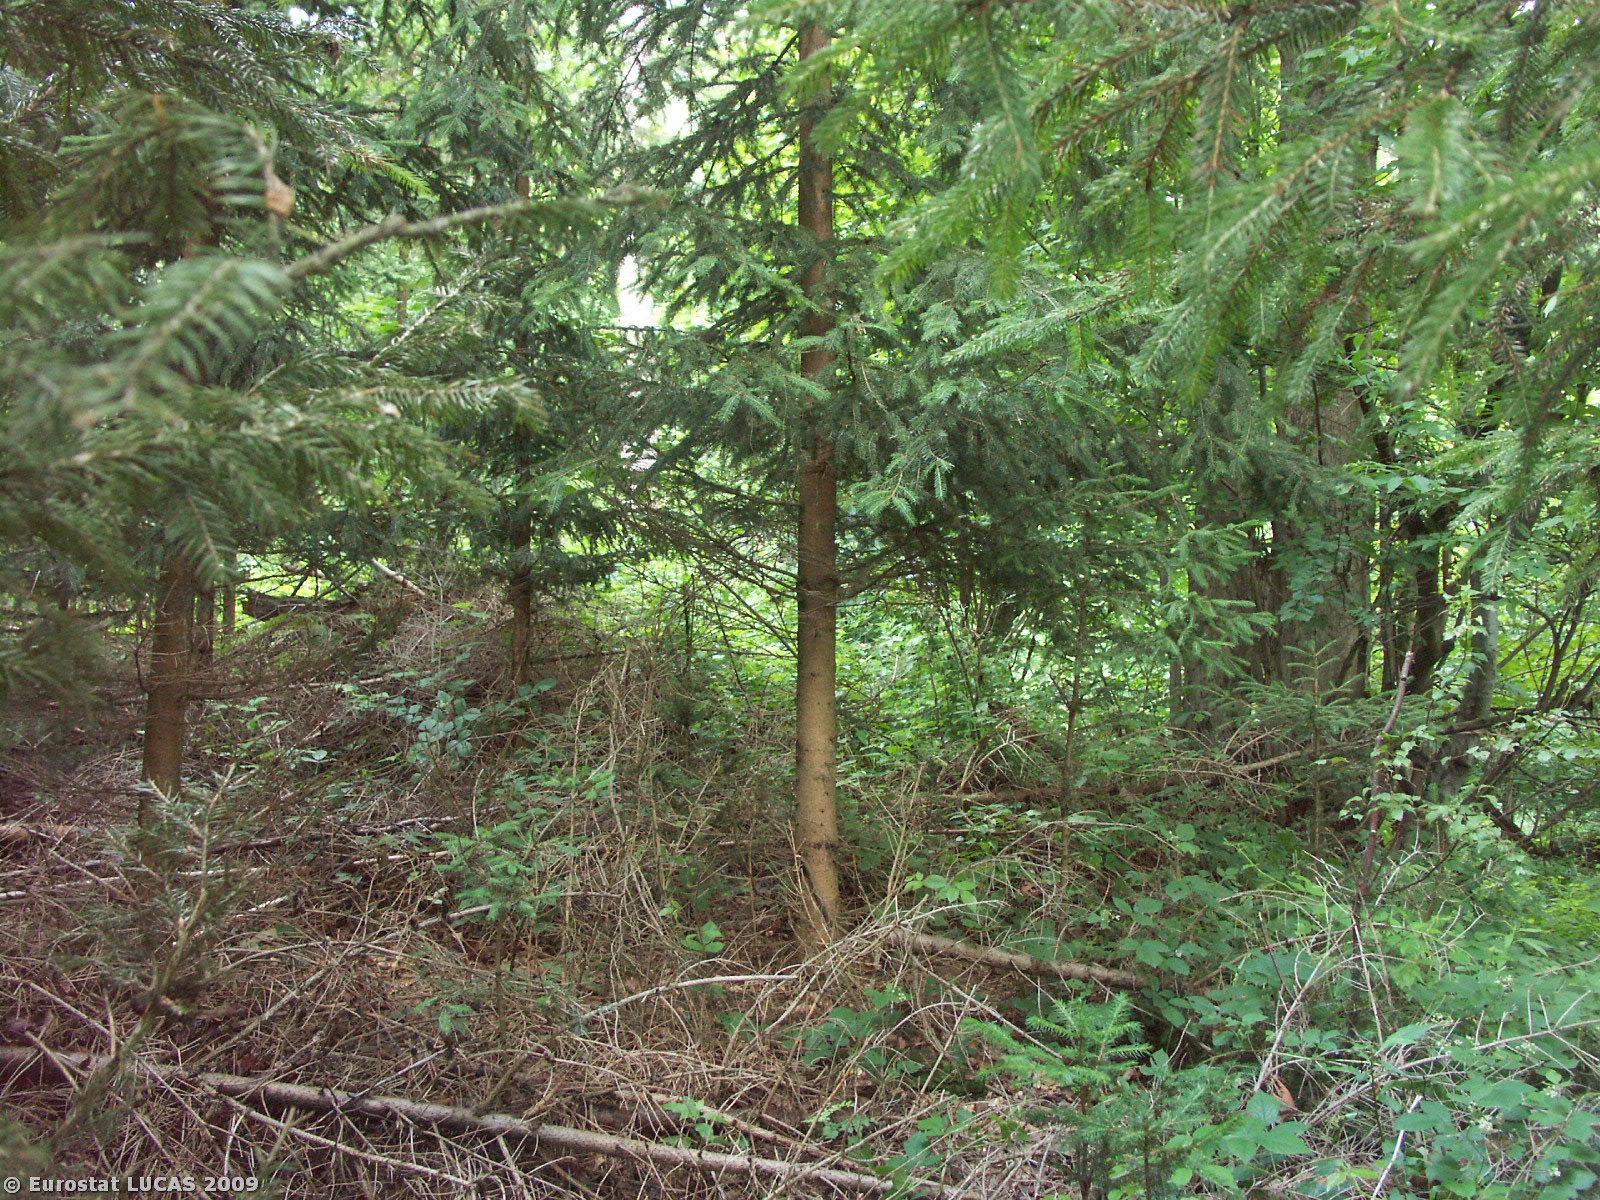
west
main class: Woodland
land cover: Mixed woodland
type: hemiboreal forest and nemoral coniferous forest and mixed broadleaved-coniferous forest
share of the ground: > 75 %
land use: Forestry
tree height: > 5 m
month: July
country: CZ
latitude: 49.8893
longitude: 17.4028
